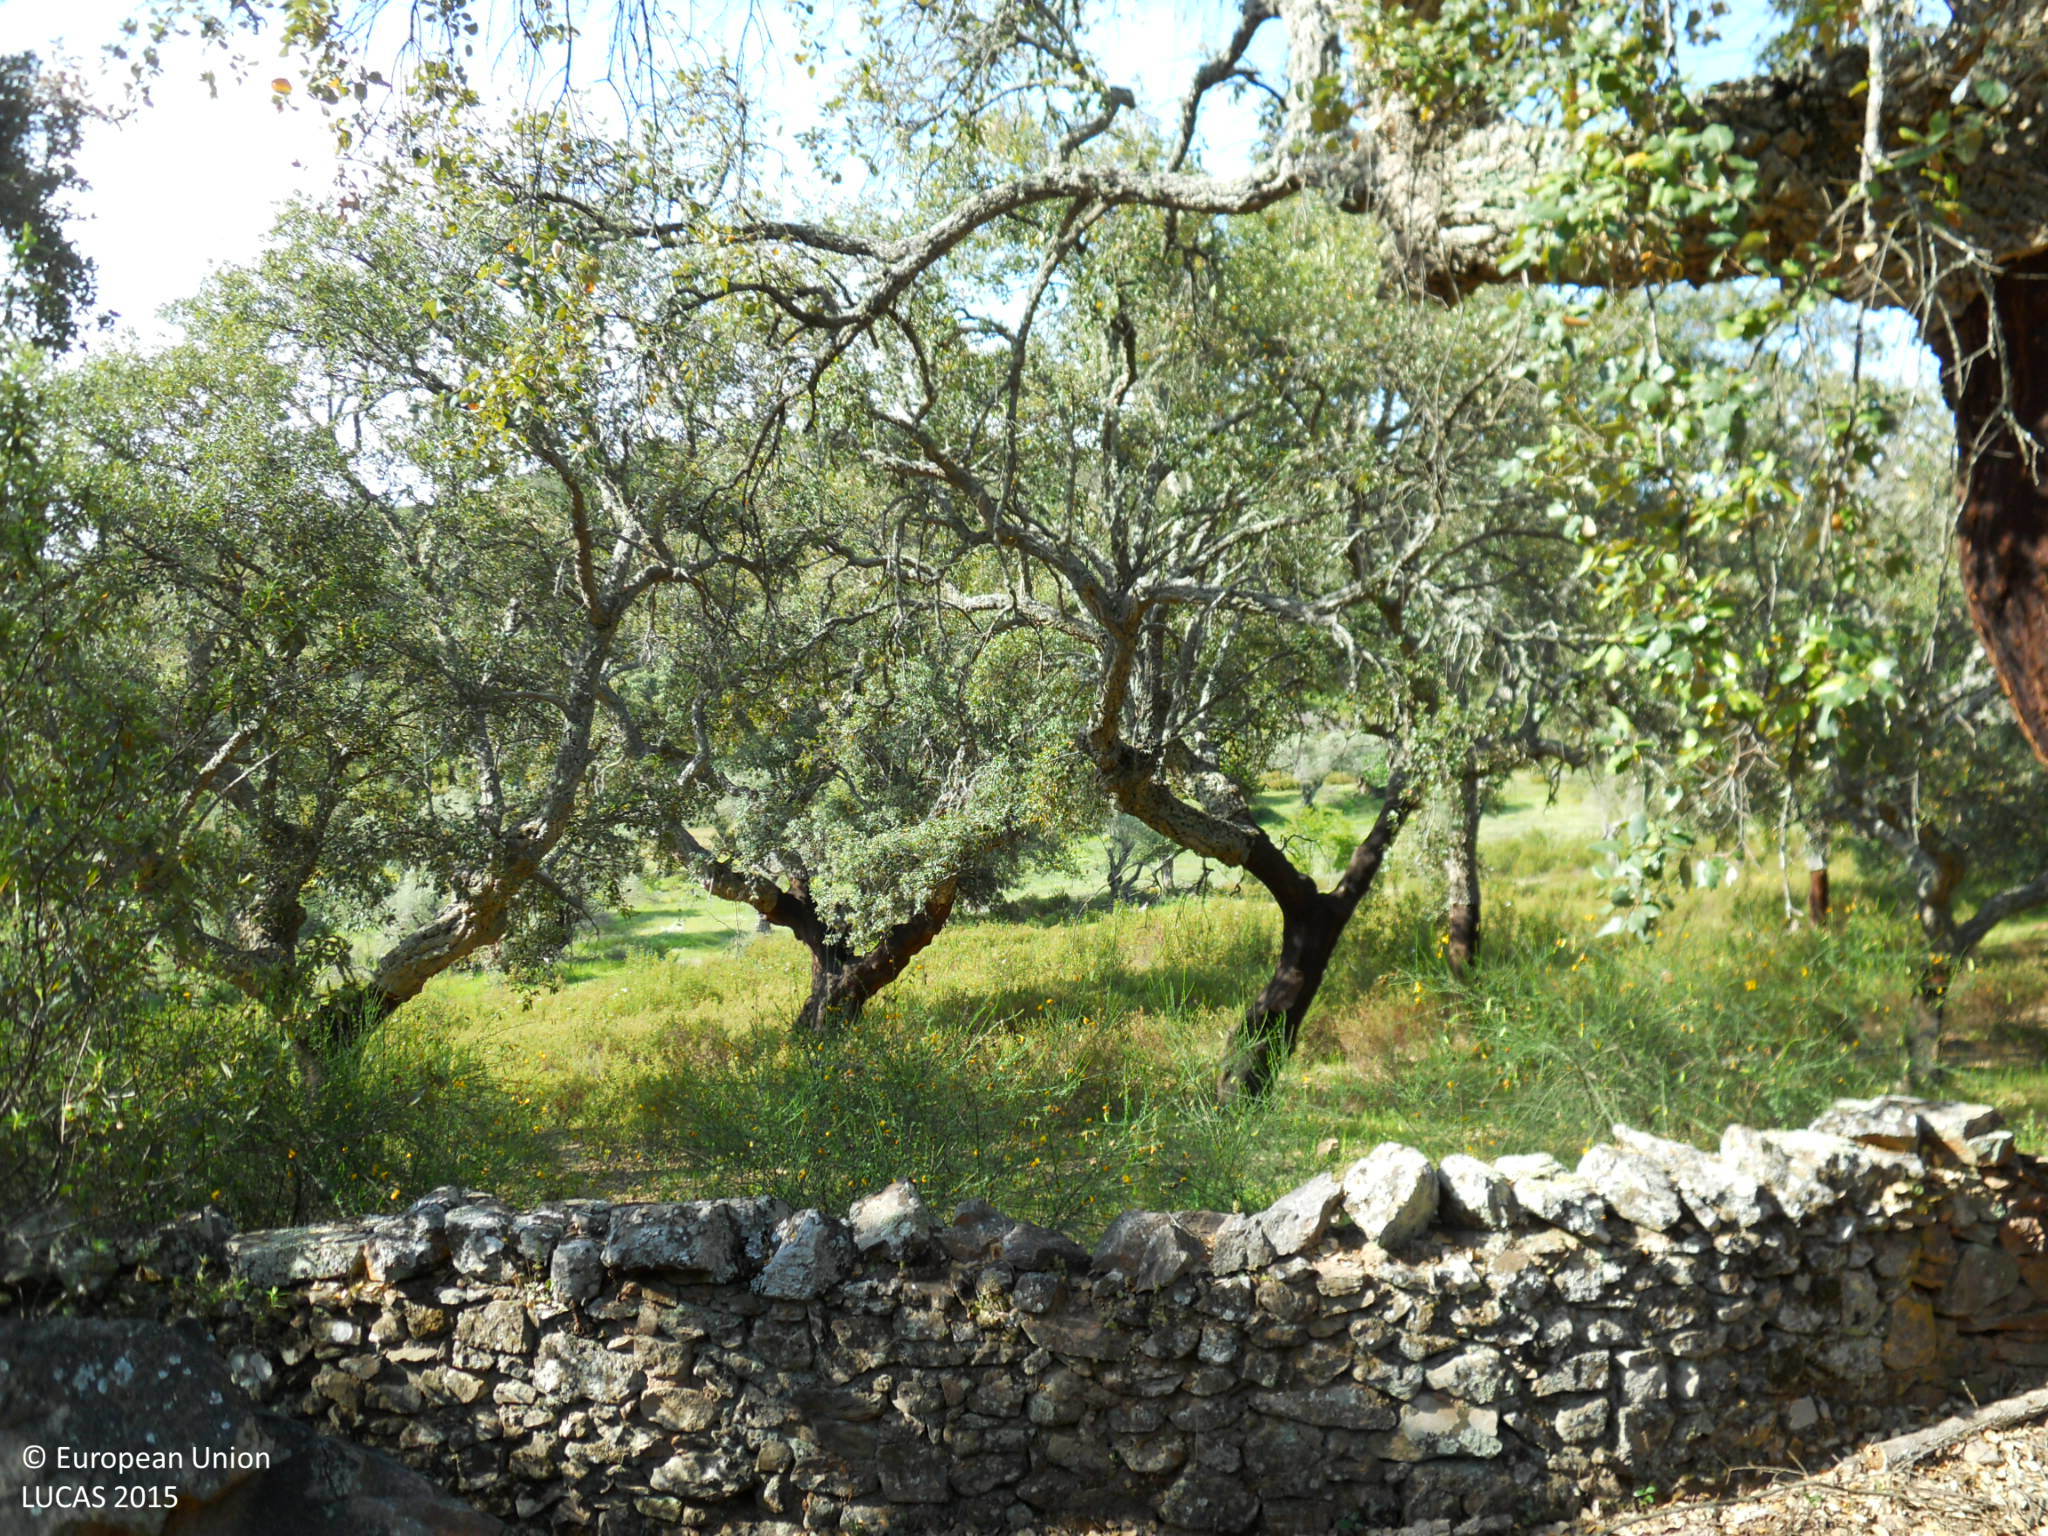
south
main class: Woodland
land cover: Broadleaved woodland
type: broadleaved evergreen forest
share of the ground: > 75 %
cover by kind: broadleaved forest trees 90 %, unconsolidated bare surface 10 %
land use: Forestry
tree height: > 5 m
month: April
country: ES
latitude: 39.2049
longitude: -6.9476
